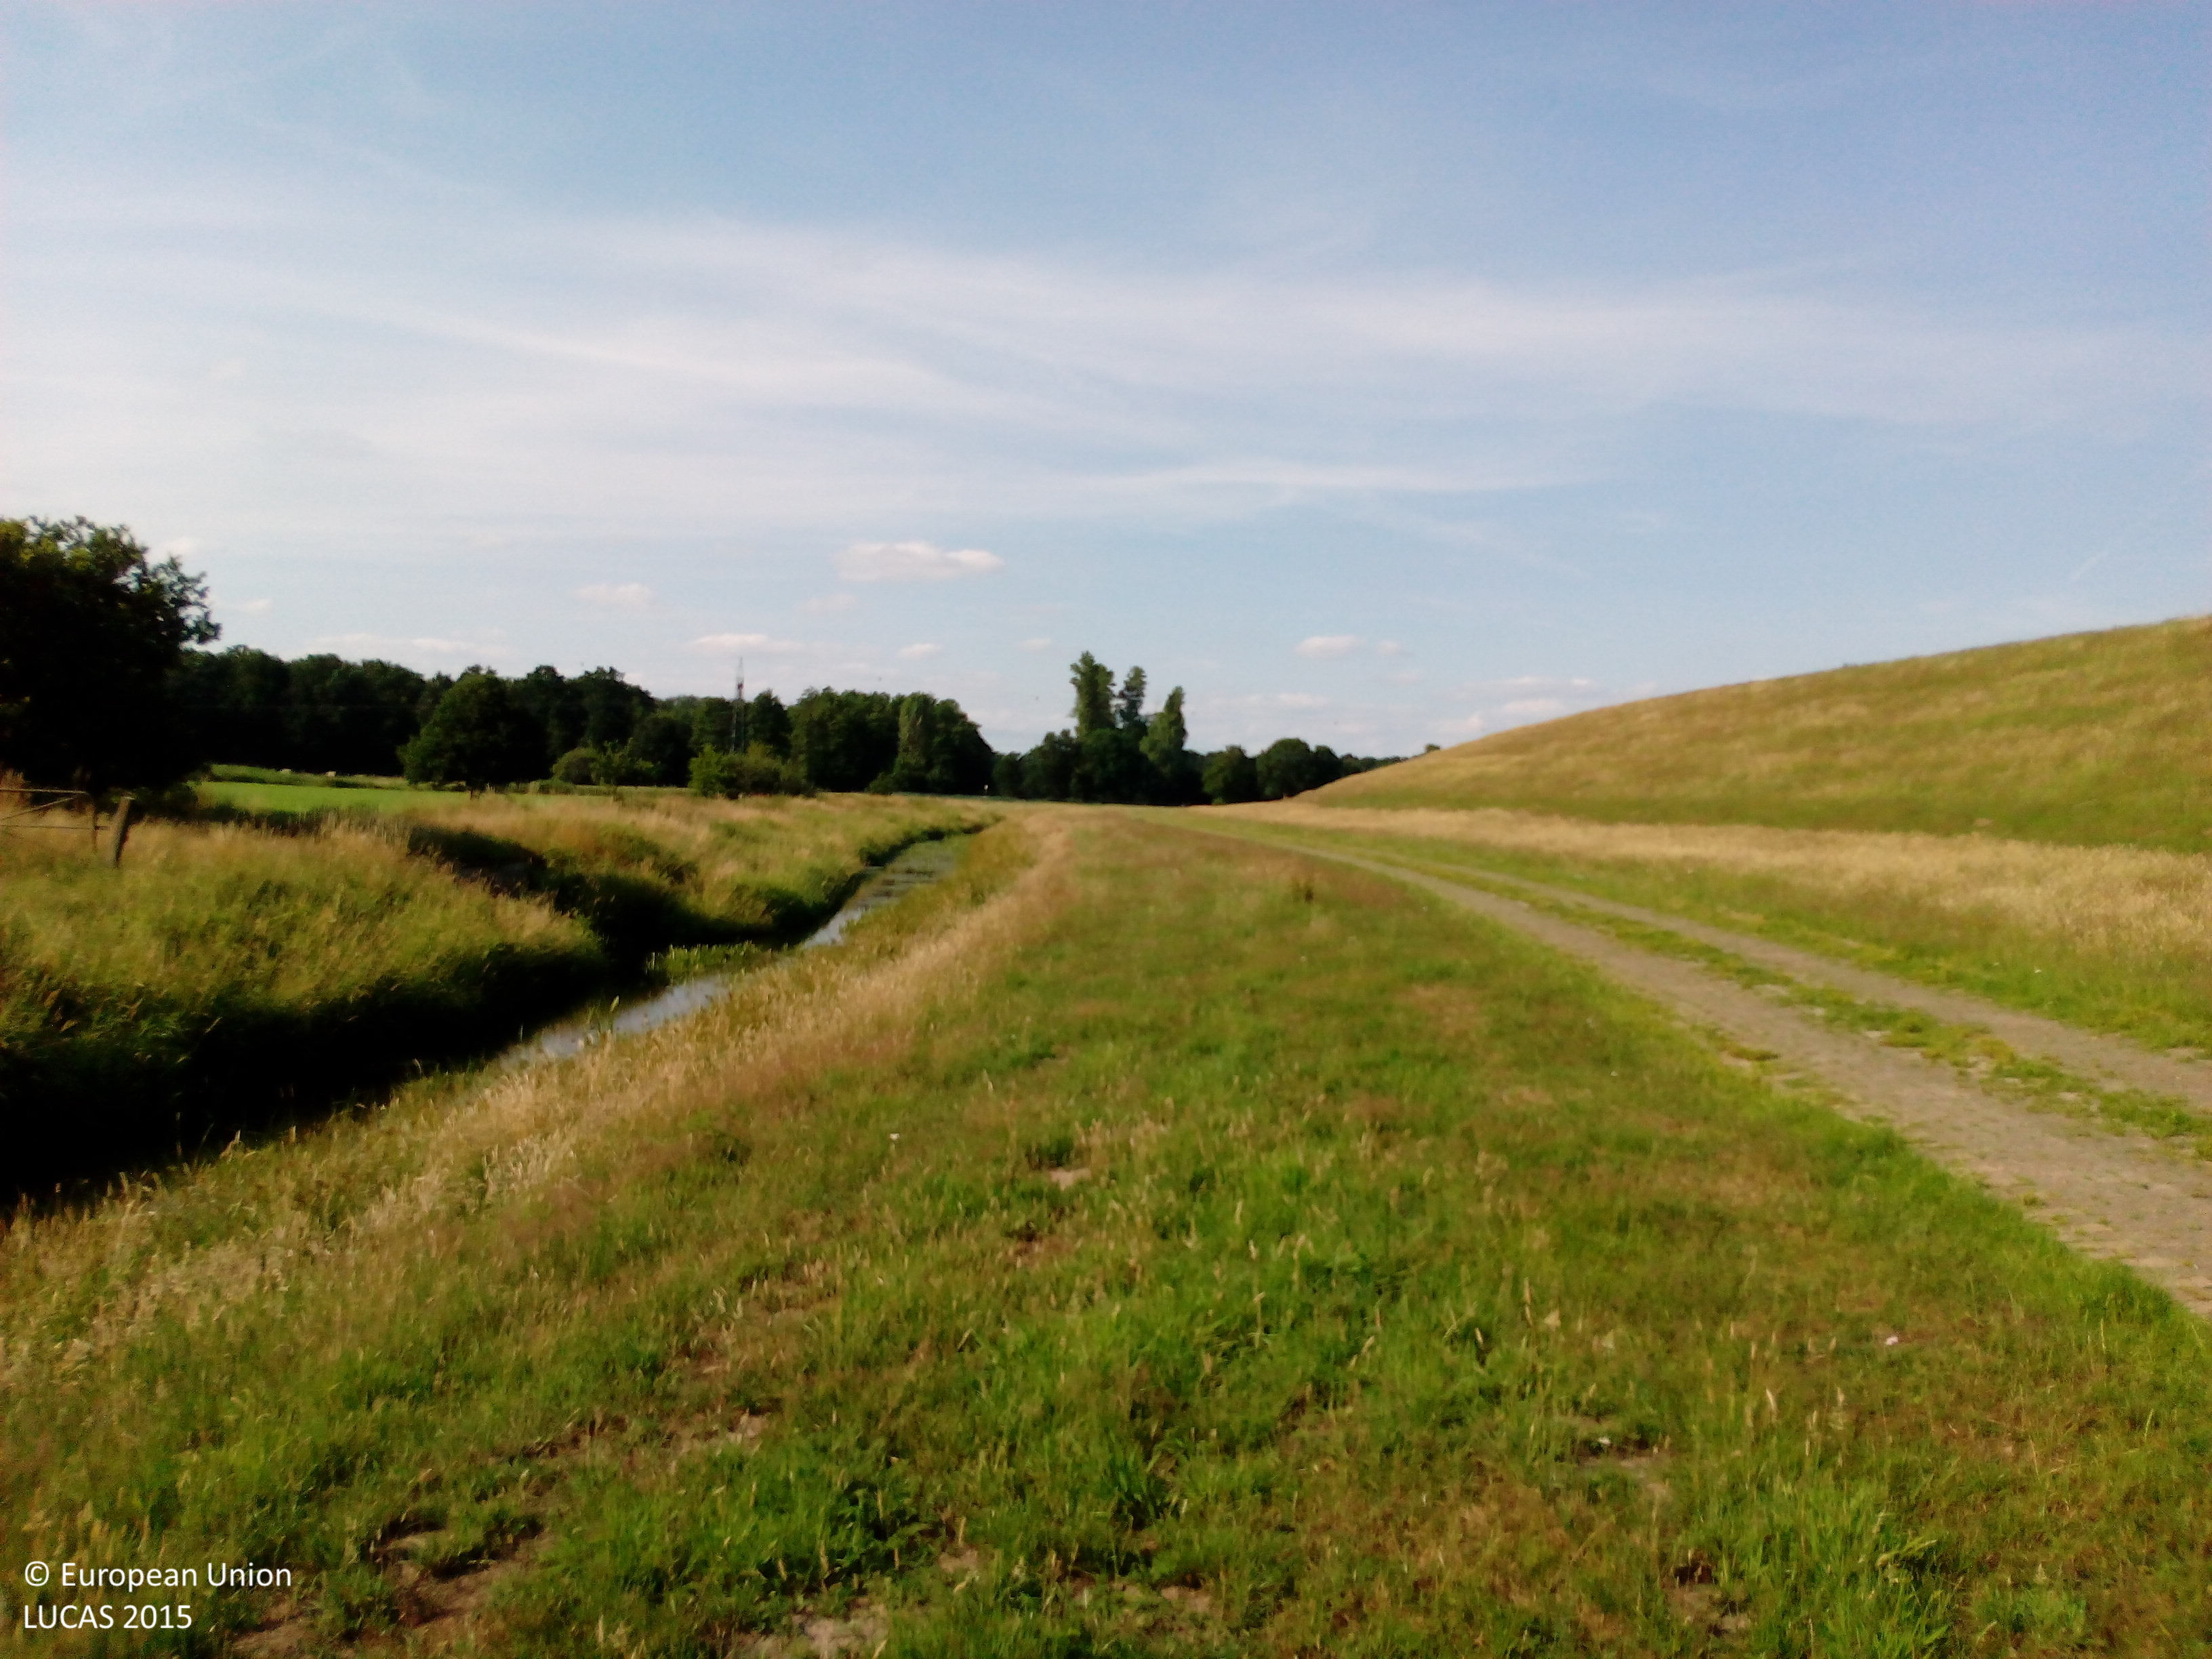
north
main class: Grassland
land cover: Spontaneously vegetated surfaces
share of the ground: > 75 %
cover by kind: herbaceous plants 100 %
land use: Agriculture (excluding fallow land and kitchen gardens)
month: July
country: DE
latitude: 52.5042
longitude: 7.9822
